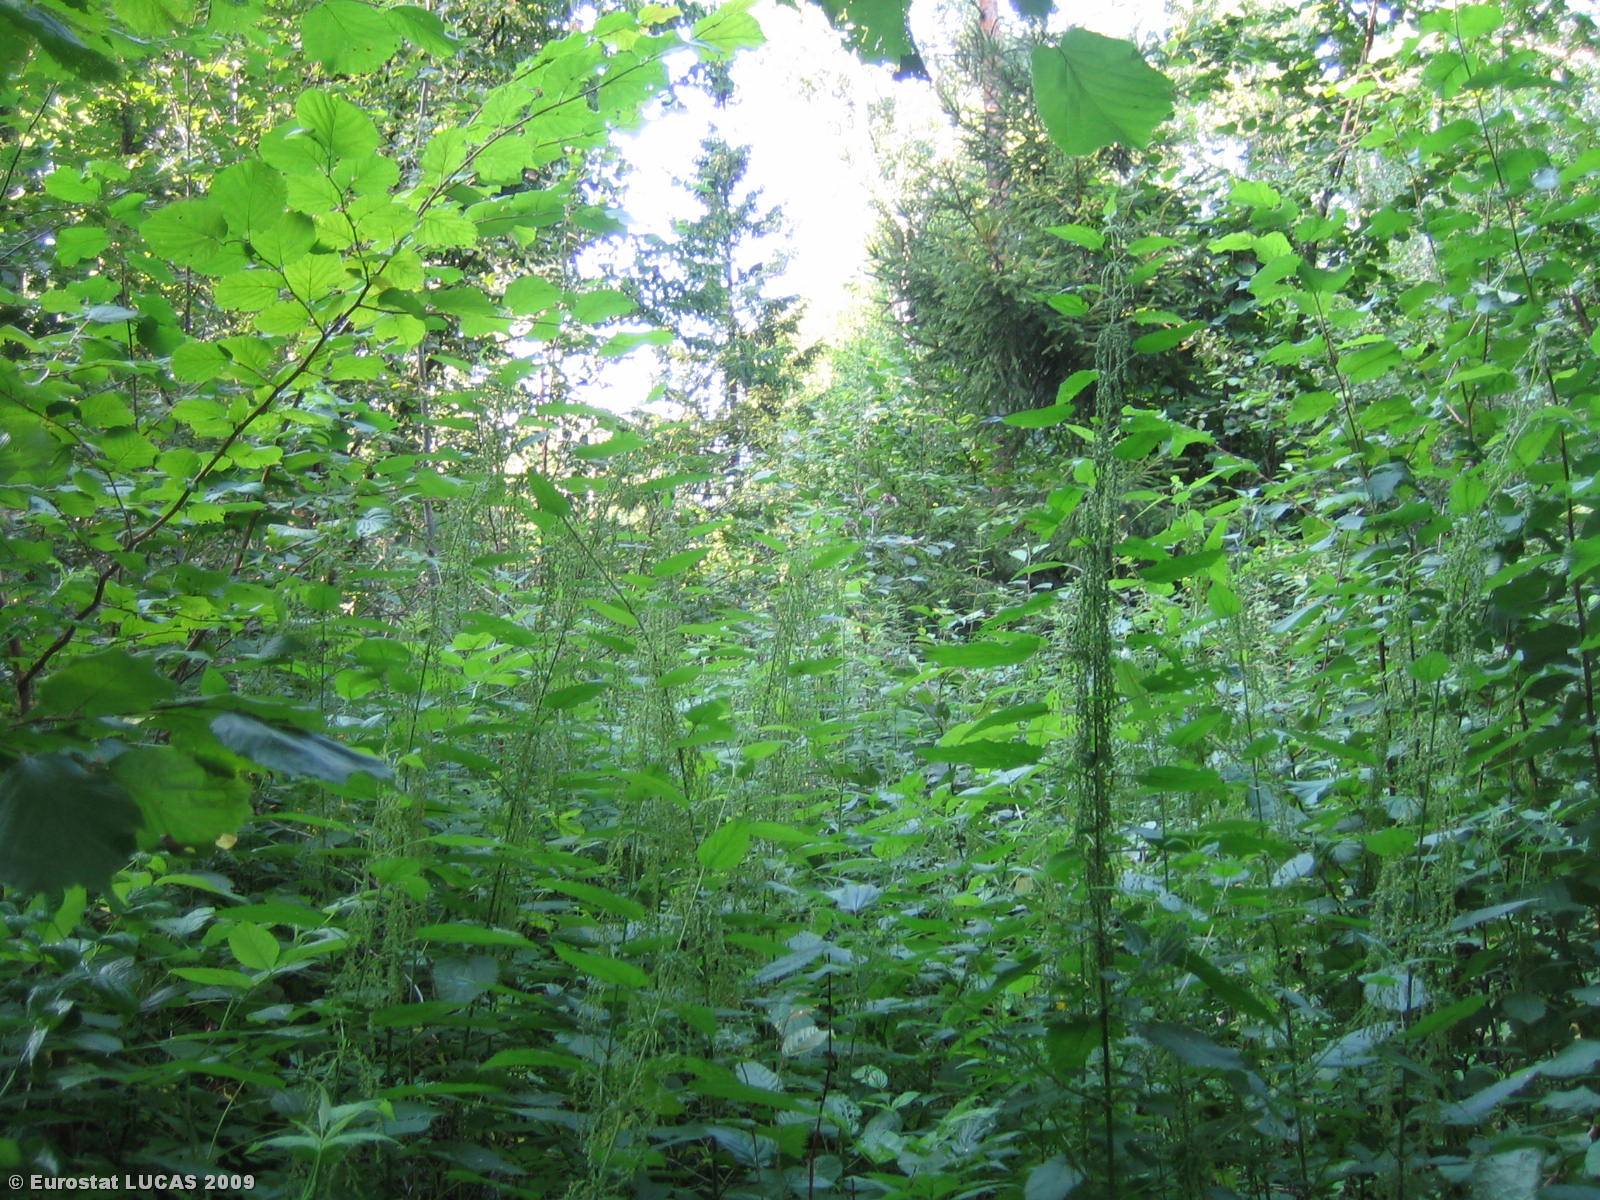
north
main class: Woodland
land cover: Mixed woodland
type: hemiboreal forest and nemoral coniferous forest and mixed broadleaved-coniferous forest
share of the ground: > 75 %
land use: Forestry
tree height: > 5 m
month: August
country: LT
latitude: 54.6656
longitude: 24.4744
